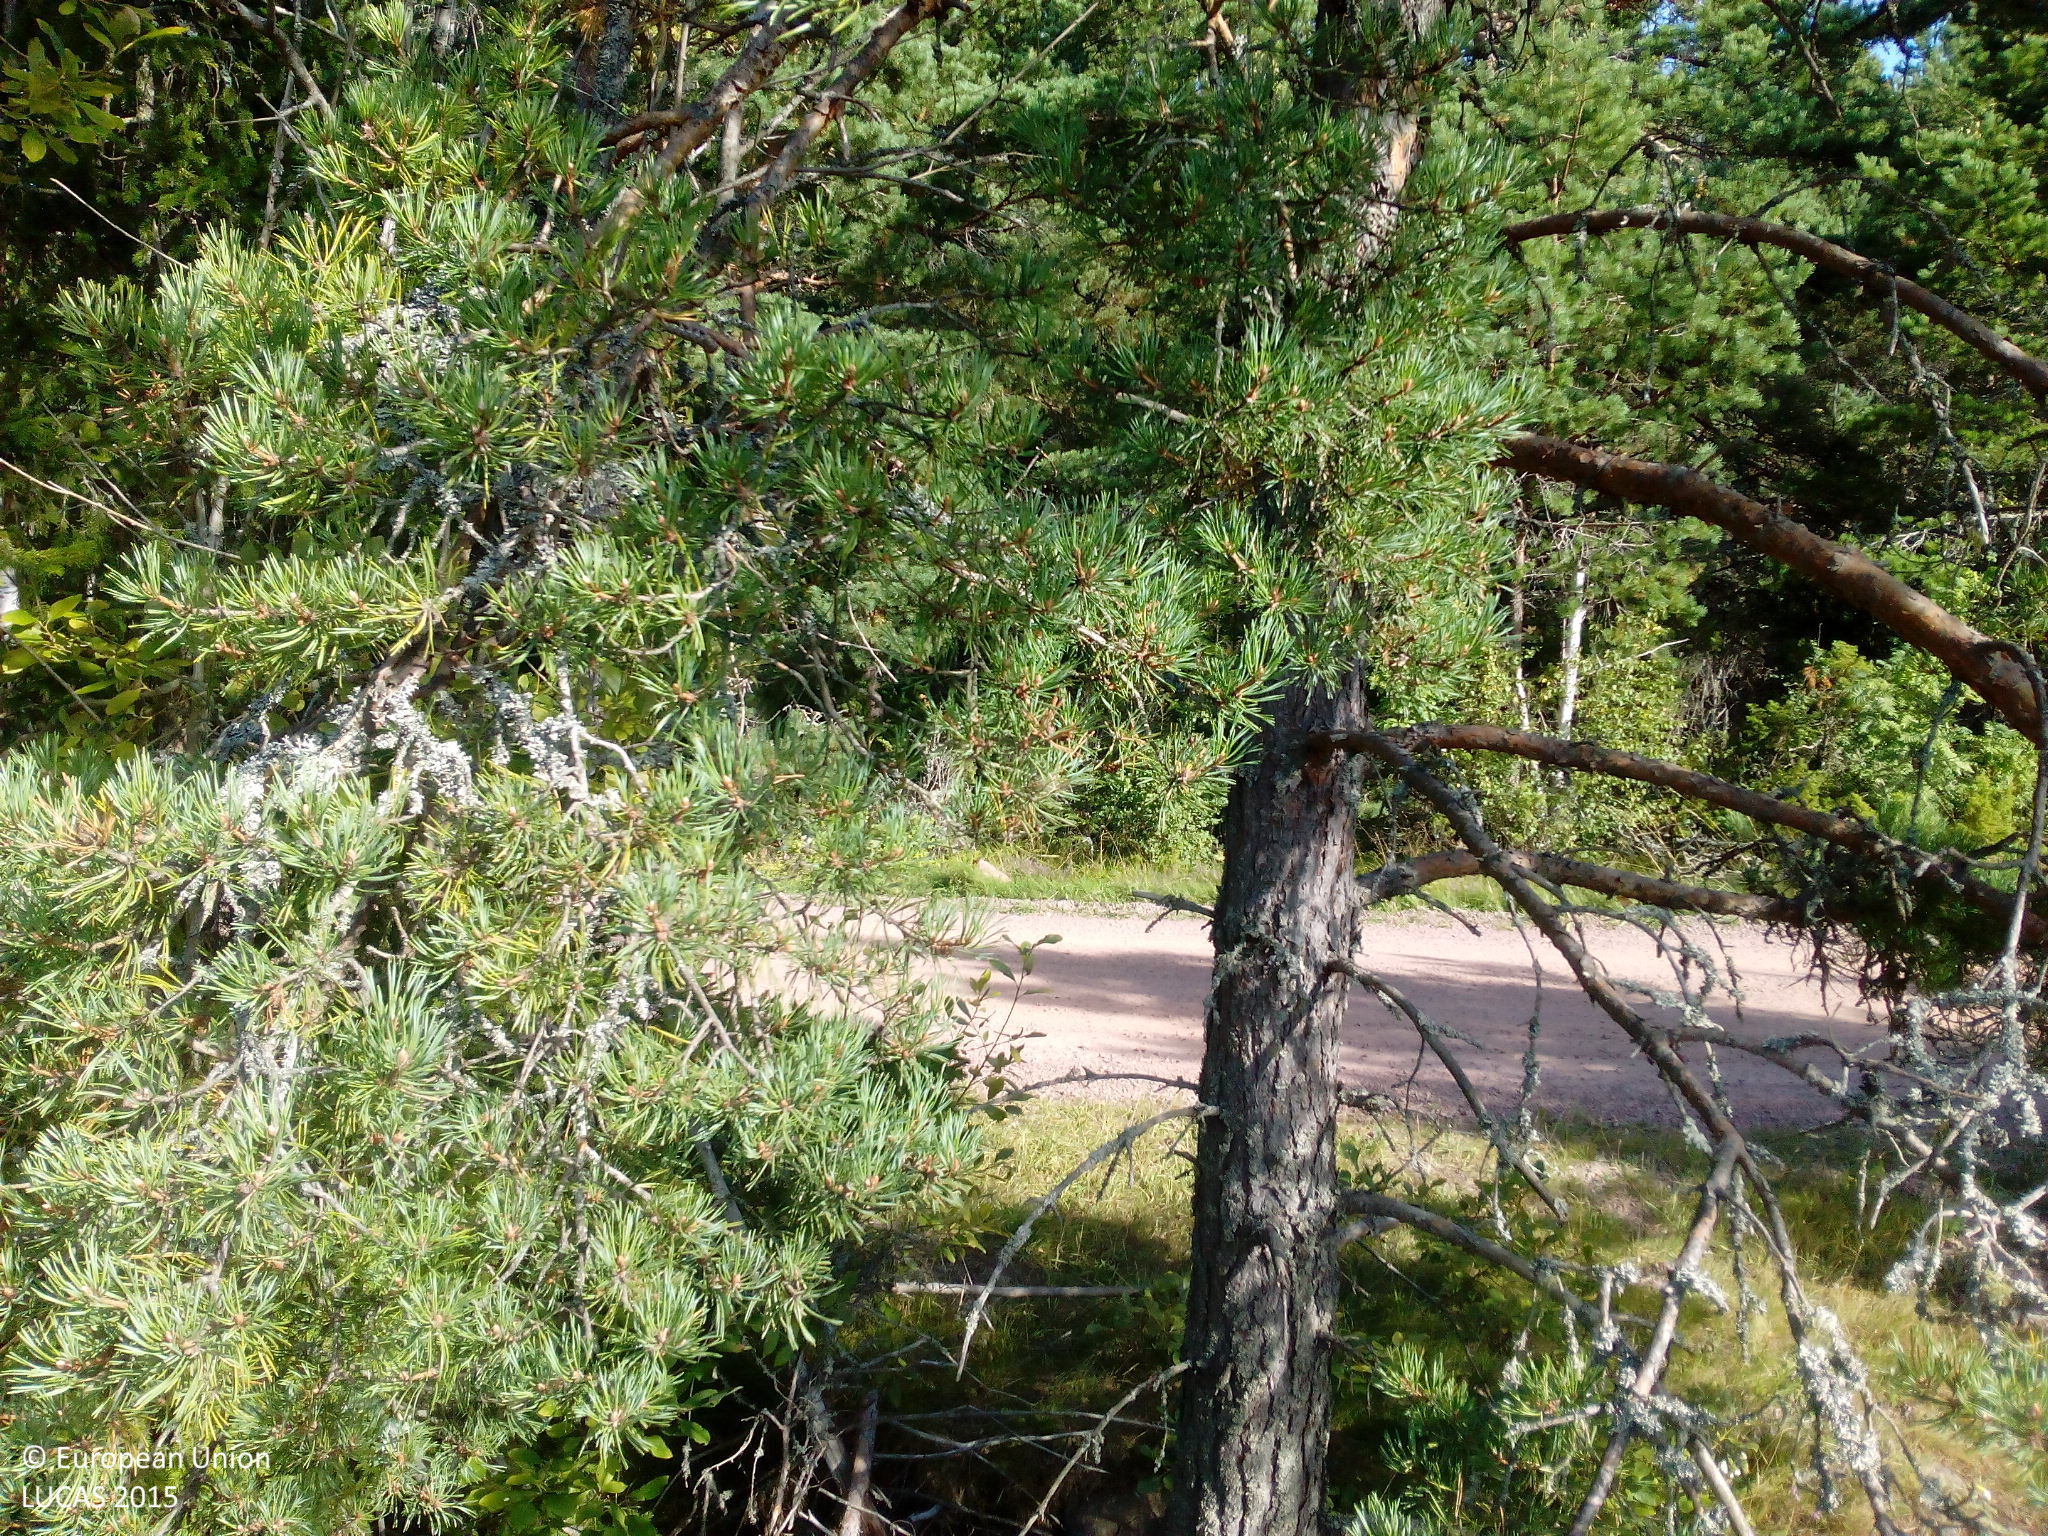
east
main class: Woodland
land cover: Pine dominated coniferous woodland
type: hemiboreal forest and nemoral coniferous forest and mixed broadleaved-coniferous forest
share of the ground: 50 - 75 %
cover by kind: coniferous forest trees 60 %, lichens and mosses 20 %, broadleaved forest trees 10 %, unconsolidated bare surface 10 %
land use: Semi-natural and natural areas not in use
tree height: > 5 m
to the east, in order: Pine dominated coniferous woodland; Paved roads, cycling and walking lanes; Pine dominated coniferous woodland; Pine dominated mixed woodland; Grassland with sparse tree/shrub cover; Electric lines; Spruce dominated mixed woodland
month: August
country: FI
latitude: 60.2627
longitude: 19.7096
